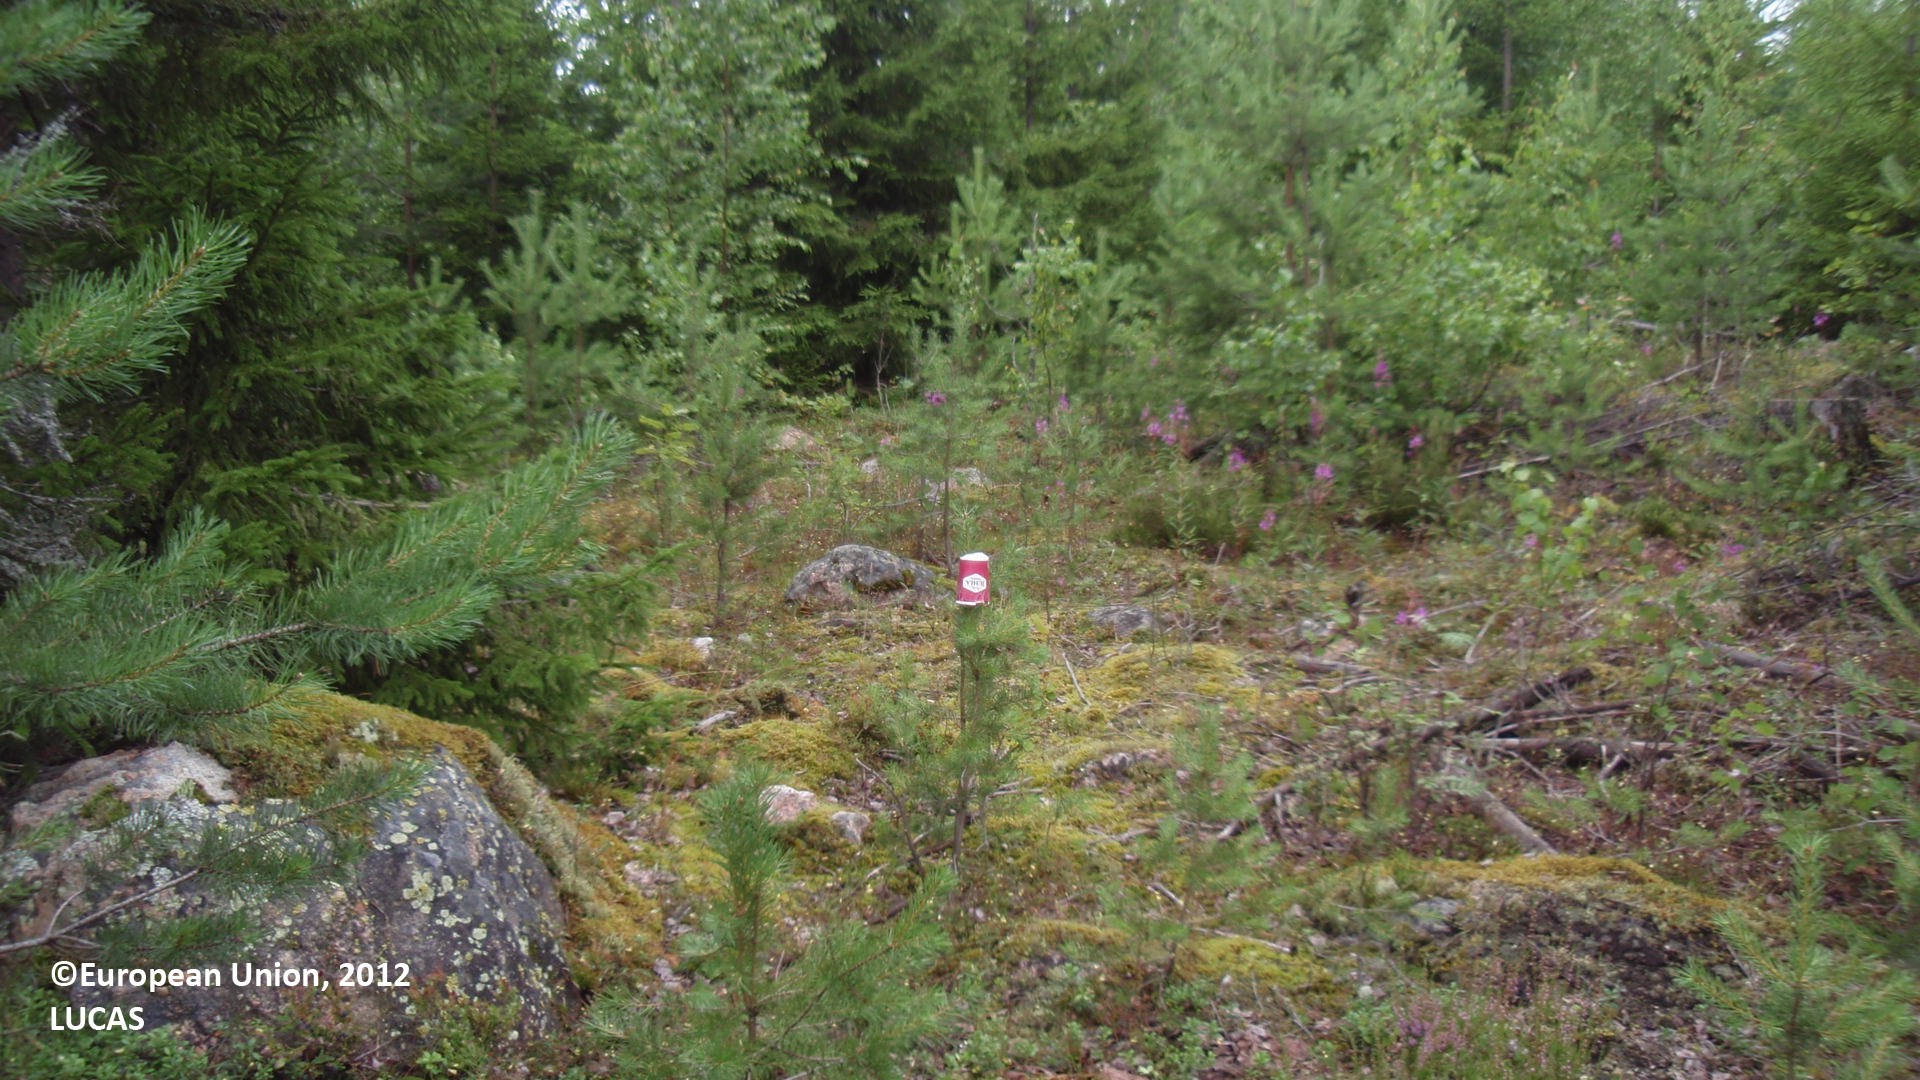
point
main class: Woodland
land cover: Spruce dominated mixed woodland
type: boreal forest
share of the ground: 10 - 25 %
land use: Forestry
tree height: > 5 m
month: July
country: FI
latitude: 61.4808
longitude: 27.3523
